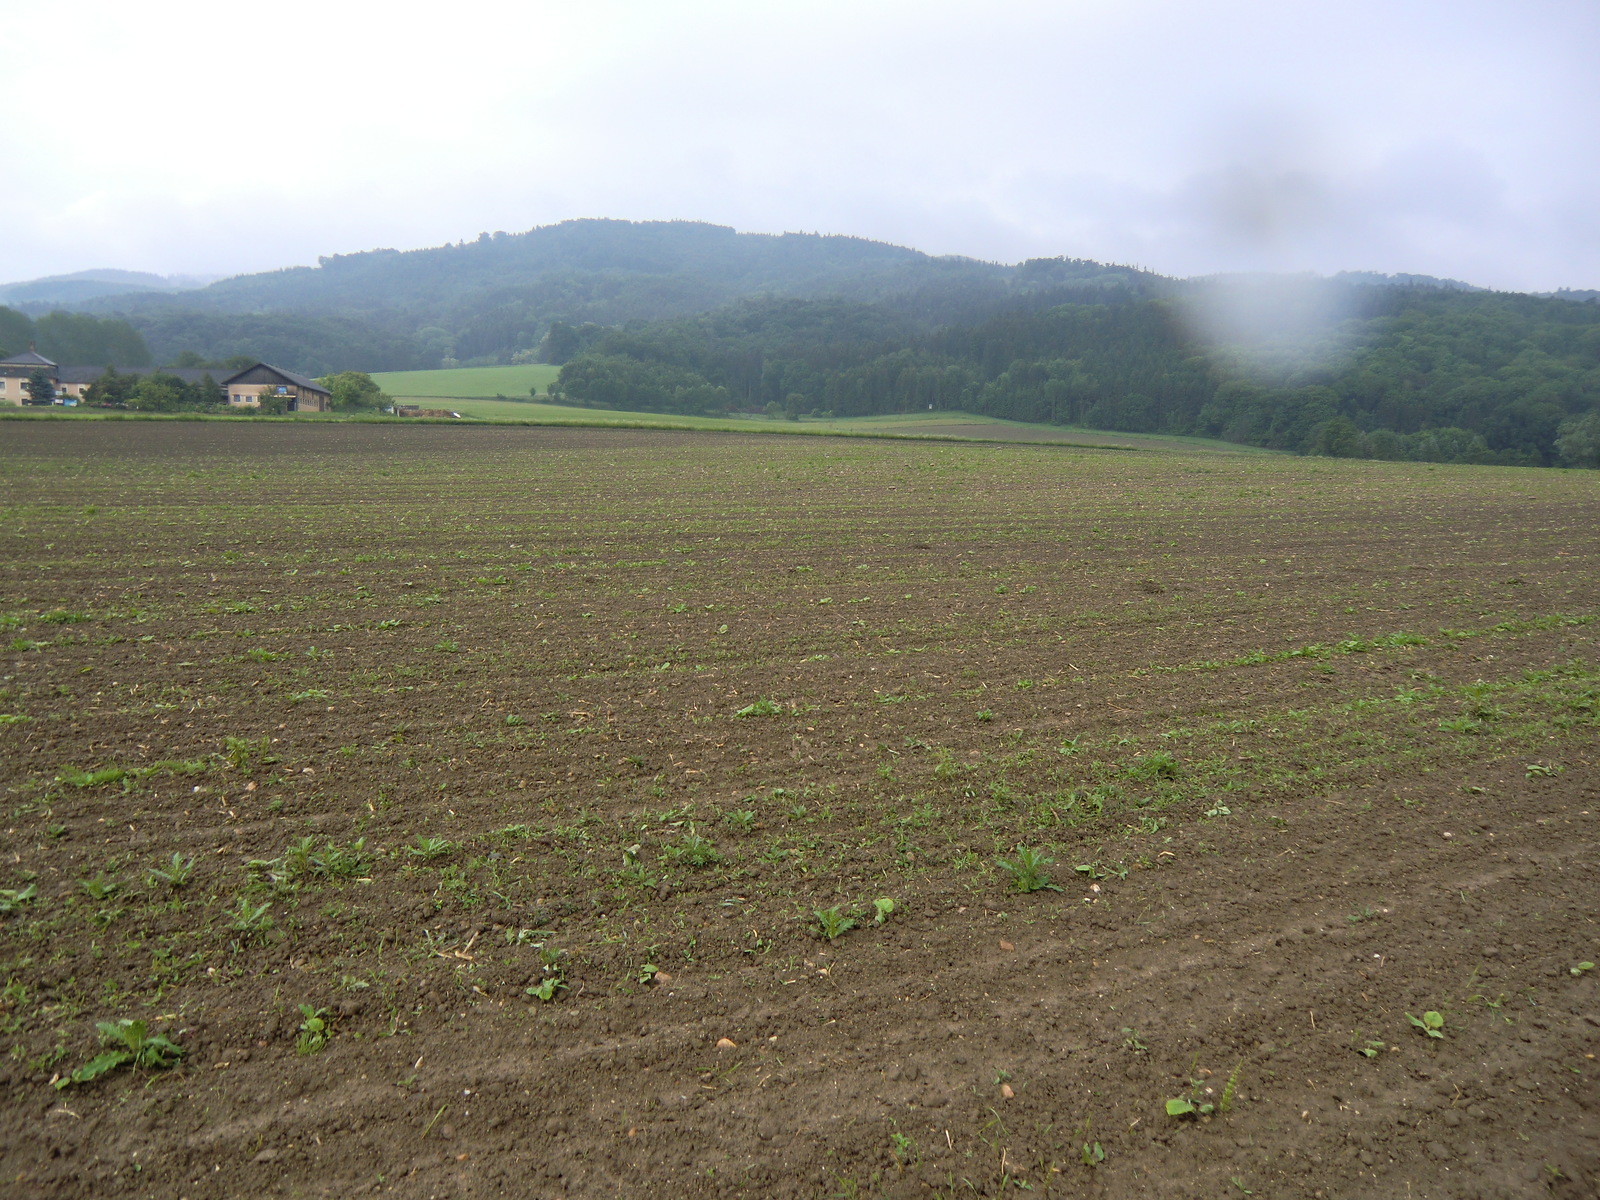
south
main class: Cropland
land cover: Other fibre and oleaginous crops
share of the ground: 25 - 50 %
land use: Agriculture (excluding fallow land and kitchen gardens)
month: May
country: AT
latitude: 48.2048
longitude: 15.2899
